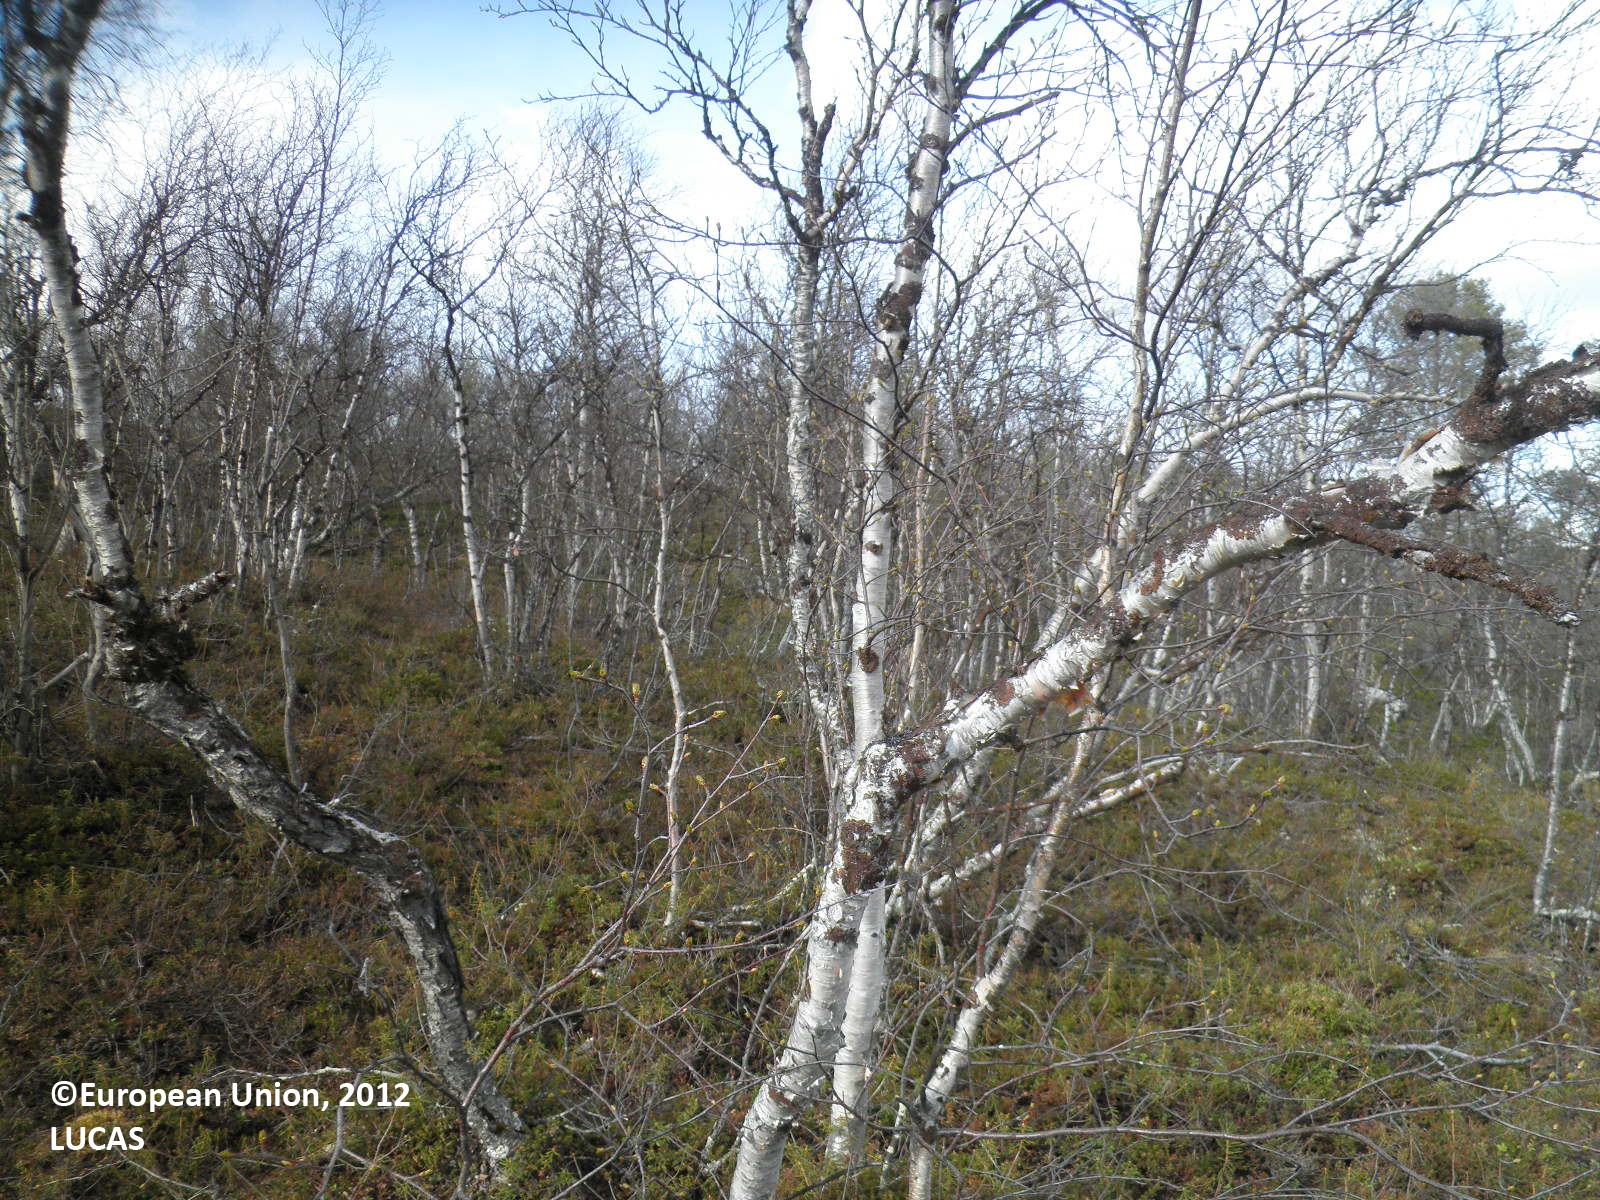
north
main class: Woodland
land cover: Broadleaved woodland
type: hemiboreal forest and nemoral coniferous forest and mixed broadleaved-coniferous forest
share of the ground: 50 - 75 %
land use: Forestry
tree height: > 5 m
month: May
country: FI
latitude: 69.7944
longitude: 26.9826
